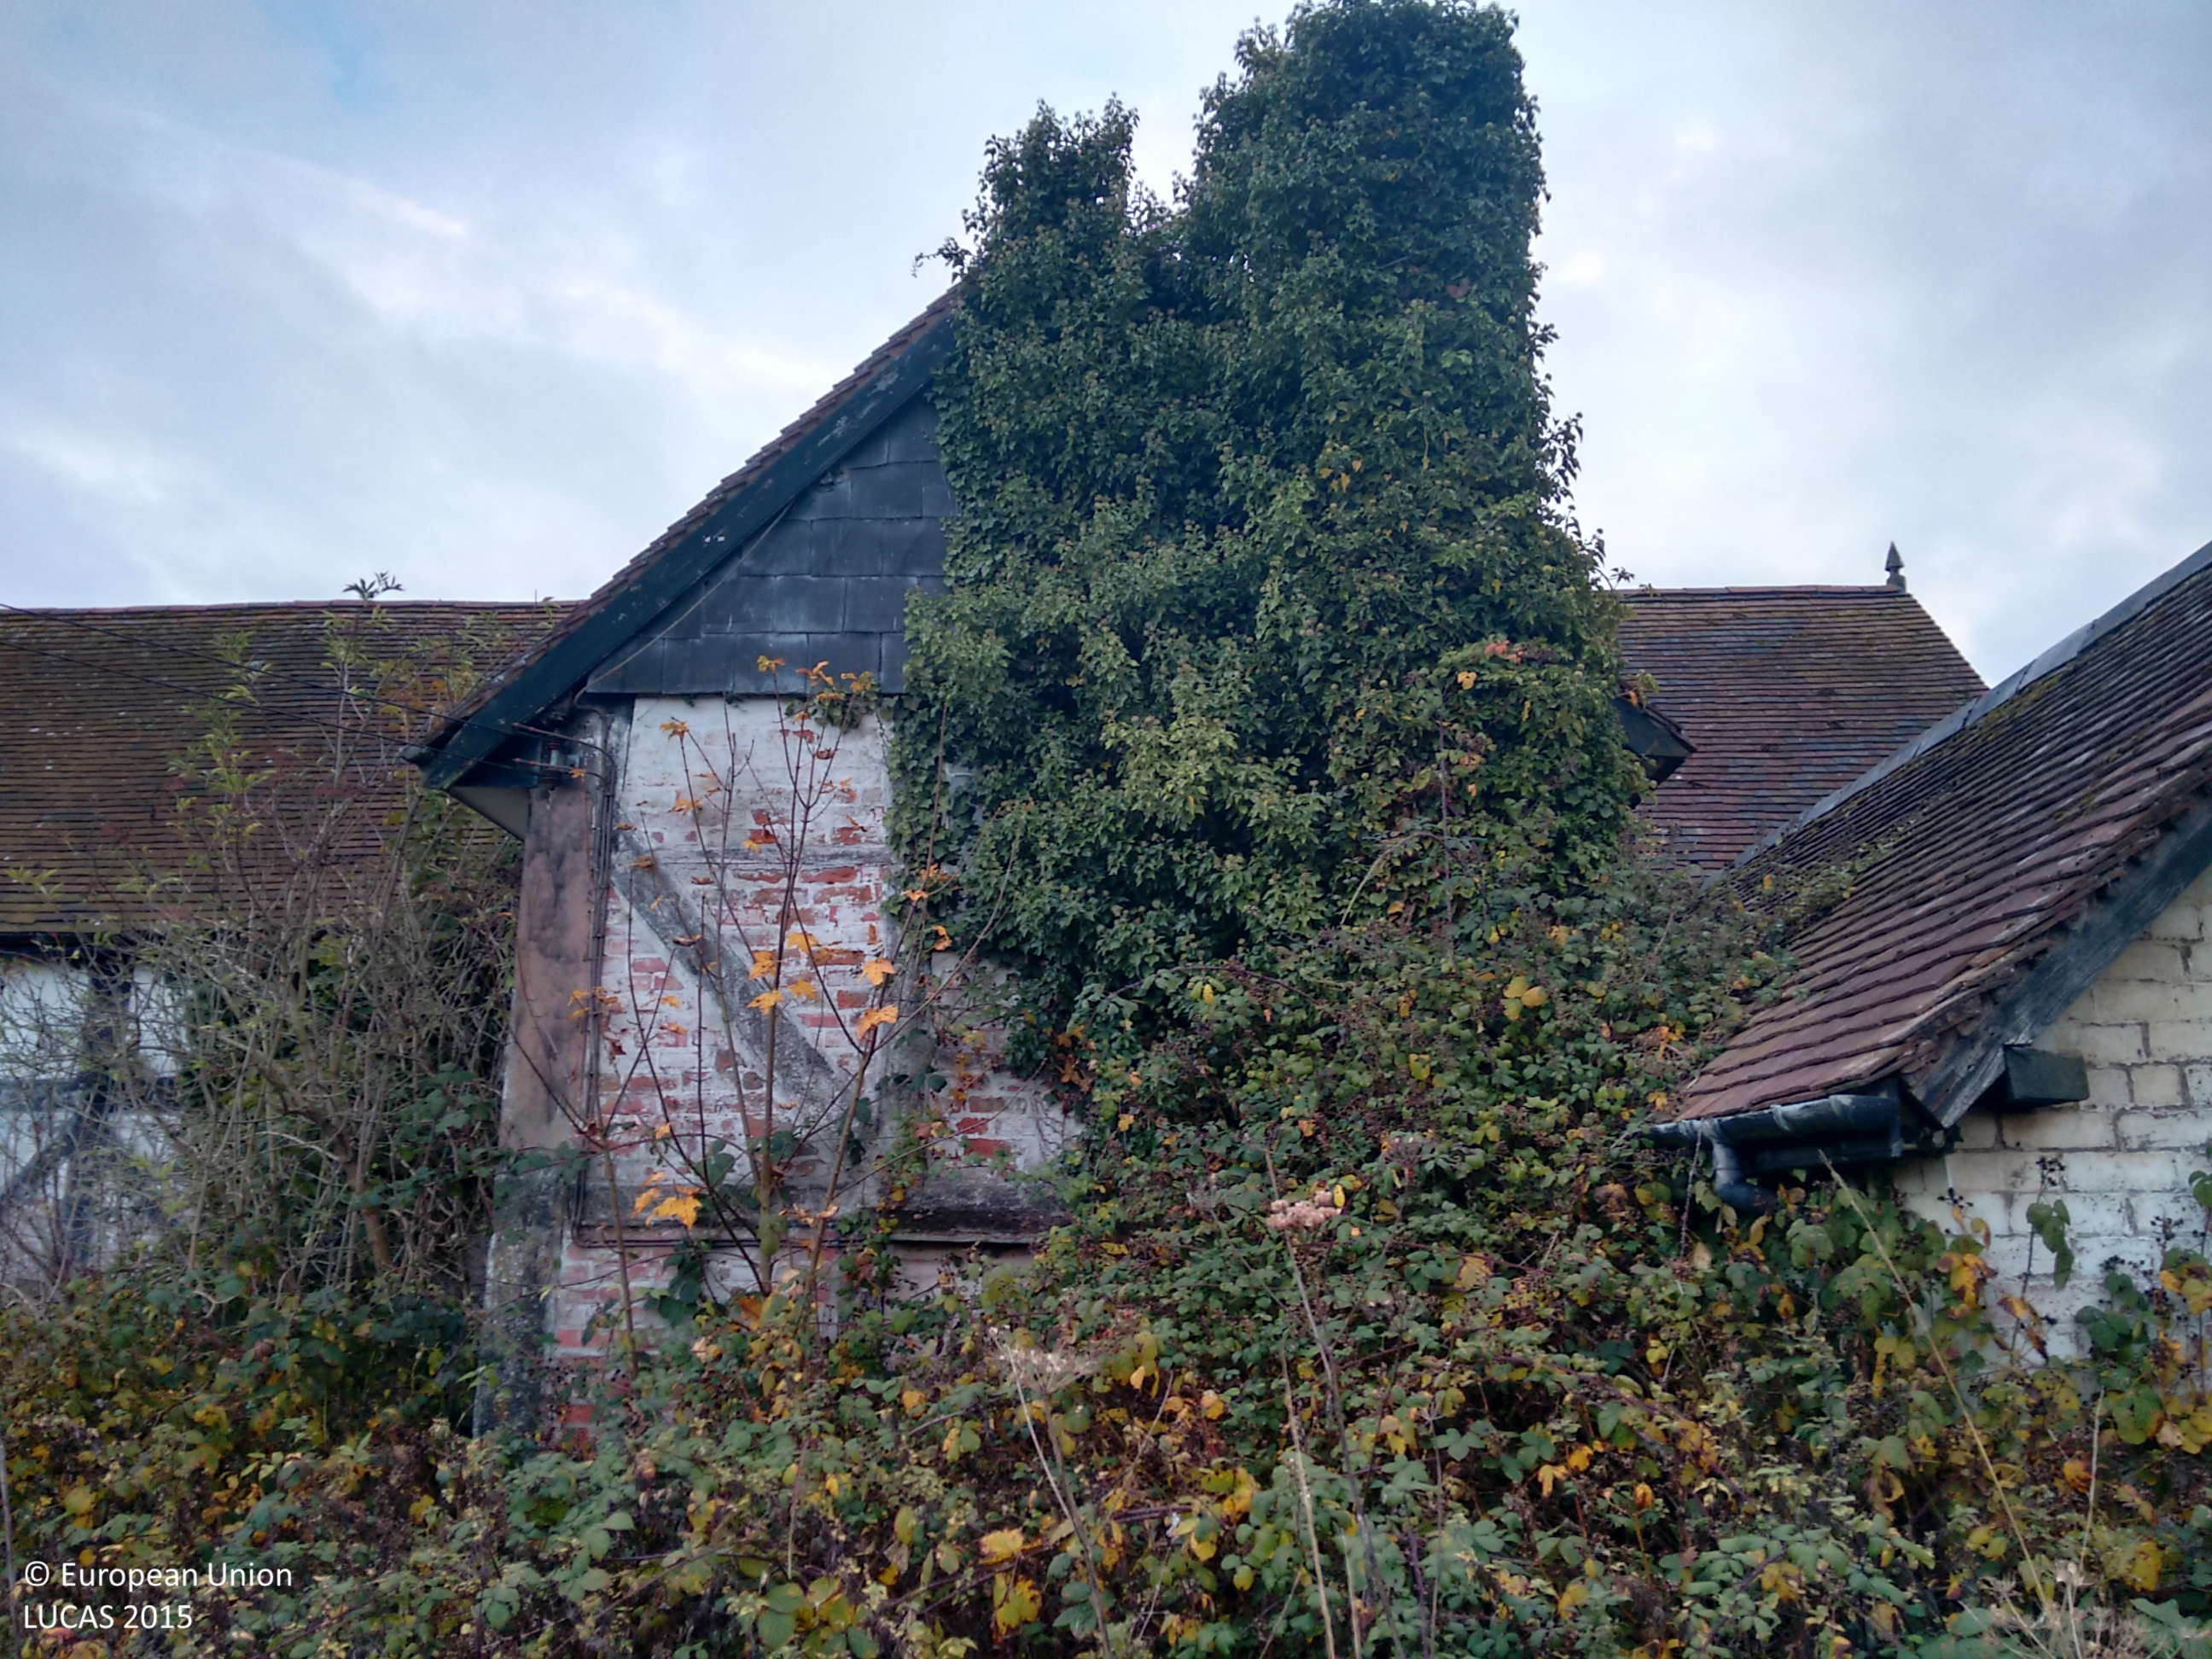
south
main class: Grassland
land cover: Grassland without tree/shrub cover
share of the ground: > 75 %
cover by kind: herbaceous plants 100 %
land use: Agriculture (excluding fallow land and kitchen gardens)
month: October
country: GB
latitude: 52.3962
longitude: -2.7534
